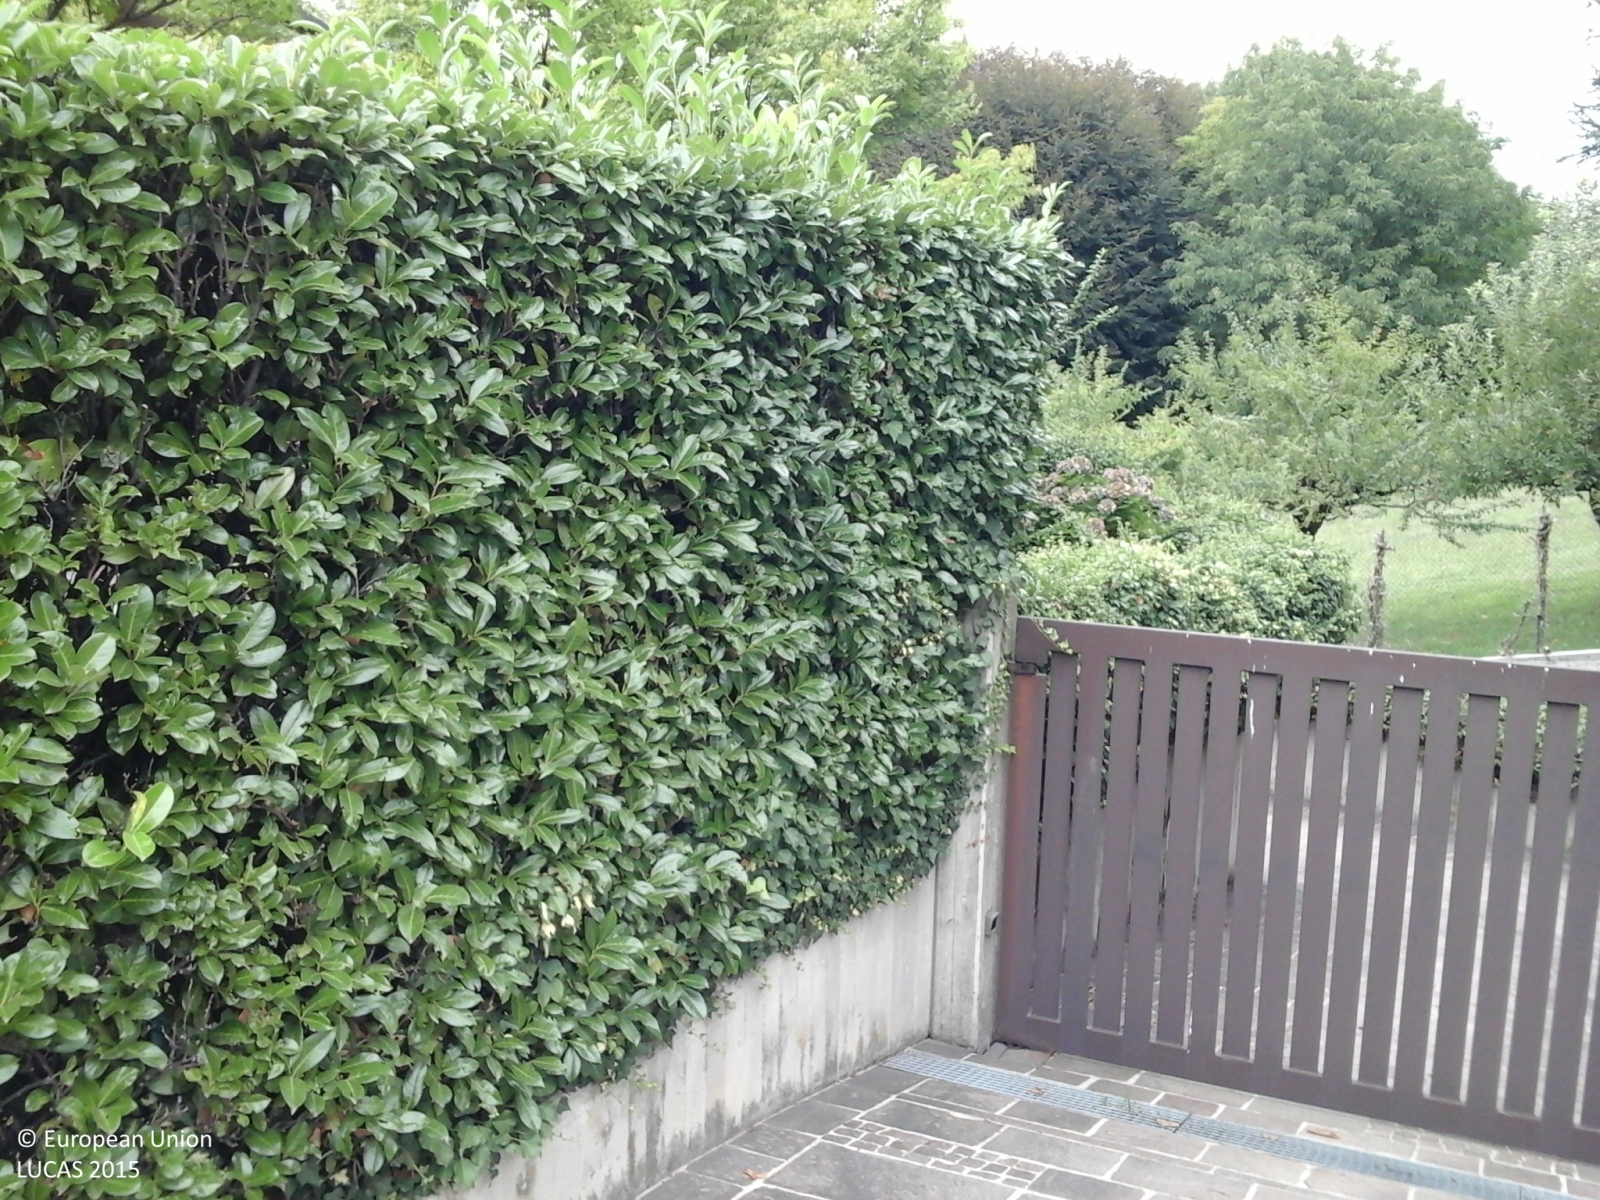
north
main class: Grassland
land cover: Grassland with sparse tree/shrub cover
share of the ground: > 75 %
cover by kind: herbaceous plants 85 %, shrubs 10 %, broadleaved forest trees 5 %
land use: Residential
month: August
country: IT
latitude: 45.7530
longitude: 9.1144
